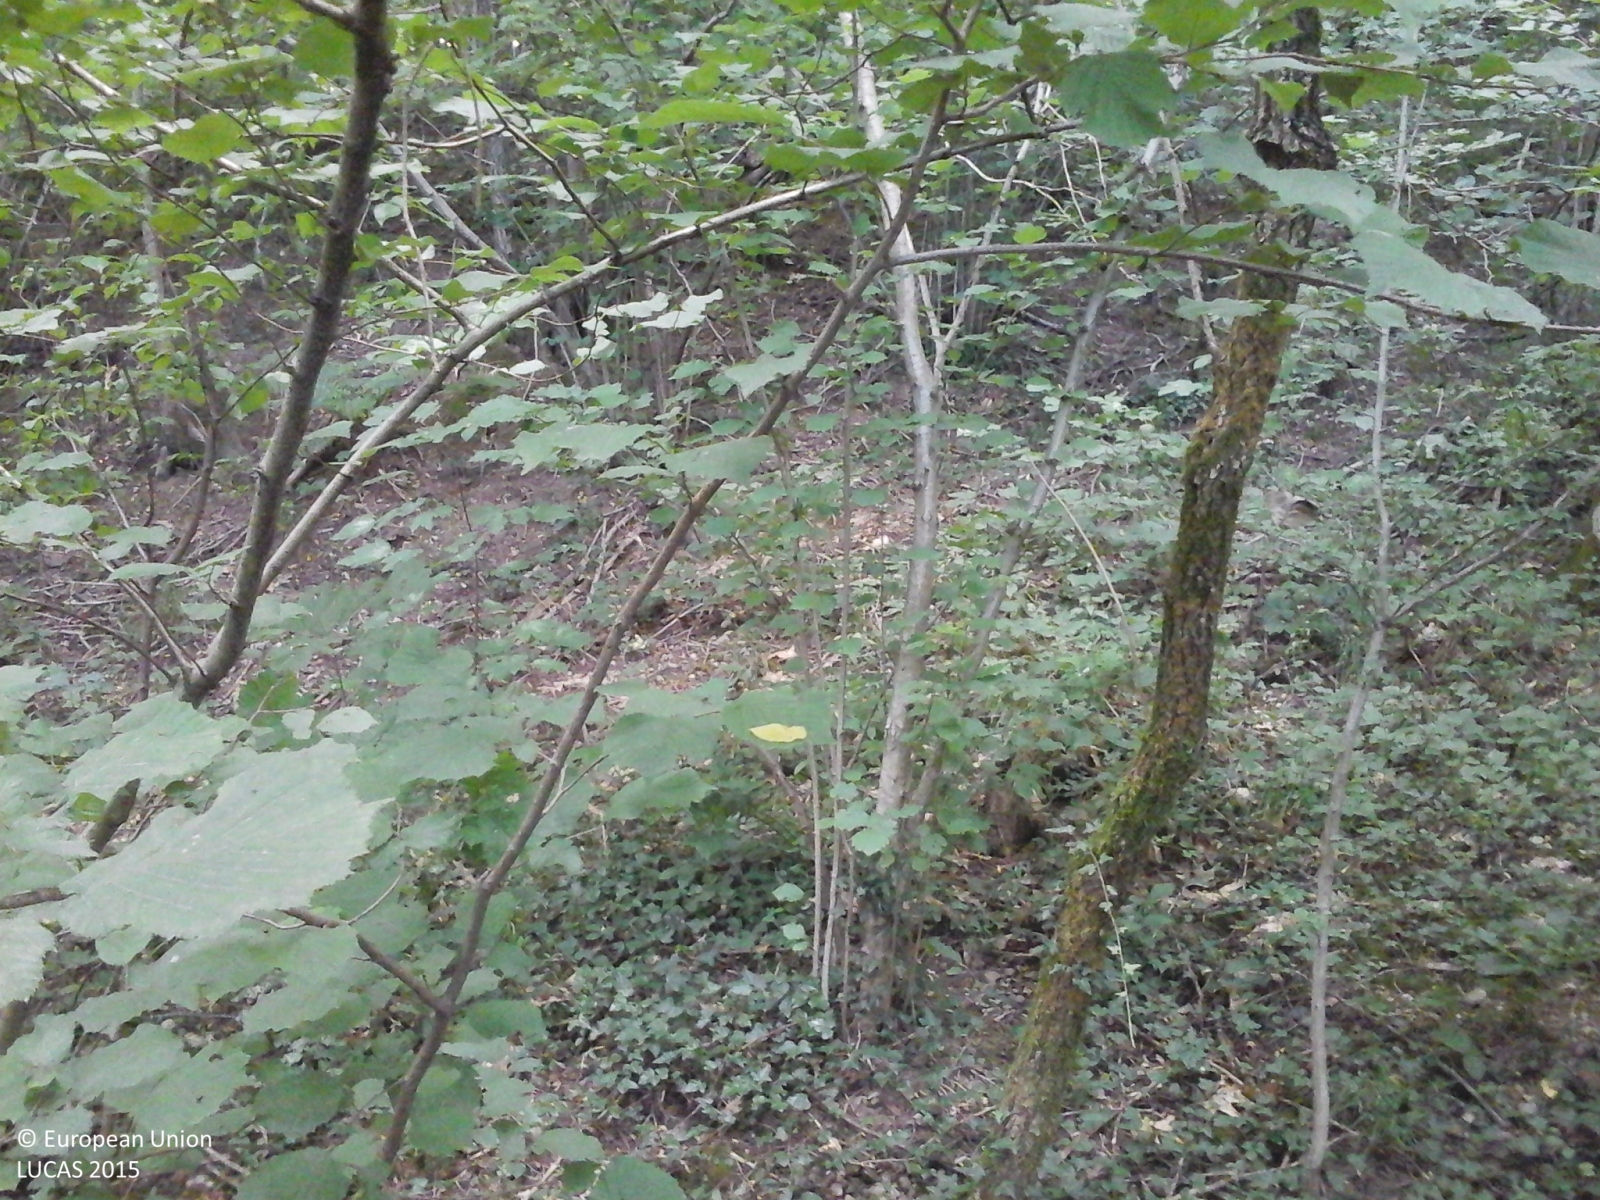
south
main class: Woodland
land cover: Broadleaved woodland
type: thermophilous deciduous forest
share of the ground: > 75 %
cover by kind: broadleaved forest trees 100 %
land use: Forestry
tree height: > 5 m
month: June
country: IT
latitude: 45.8208
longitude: 8.7020
